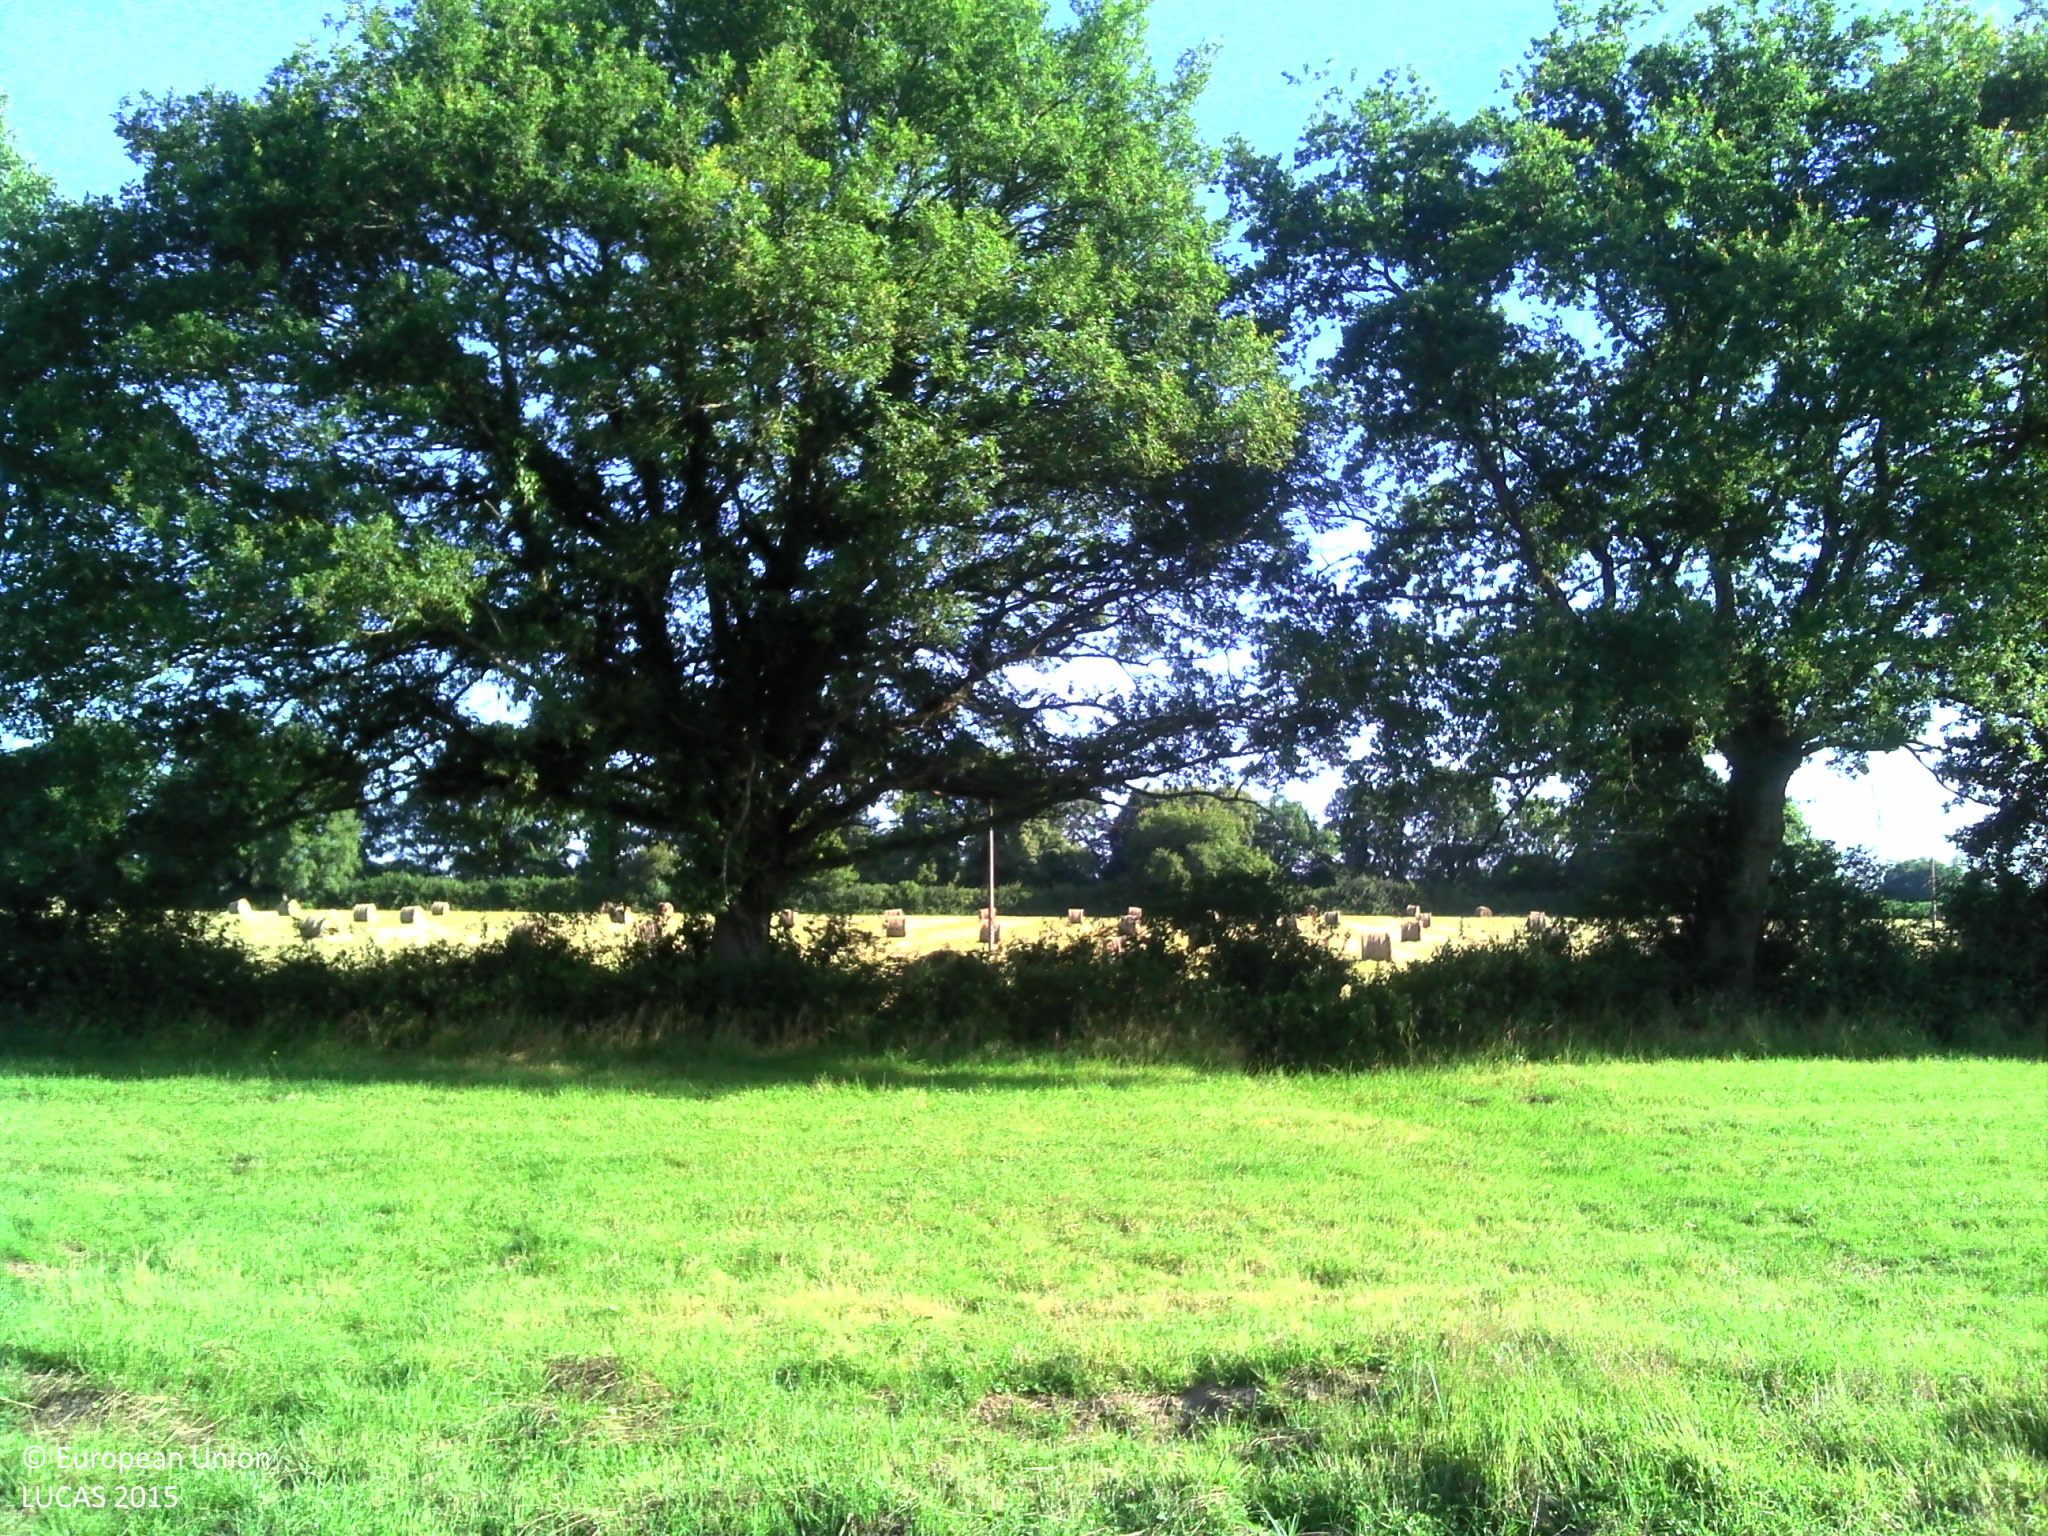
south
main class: Grassland
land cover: Grassland without tree/shrub cover
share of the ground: > 75 %
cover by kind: herbaceous plants 100 %
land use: Agriculture (excluding fallow land and kitchen gardens)
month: June
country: FR
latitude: 46.8238
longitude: 2.9569
